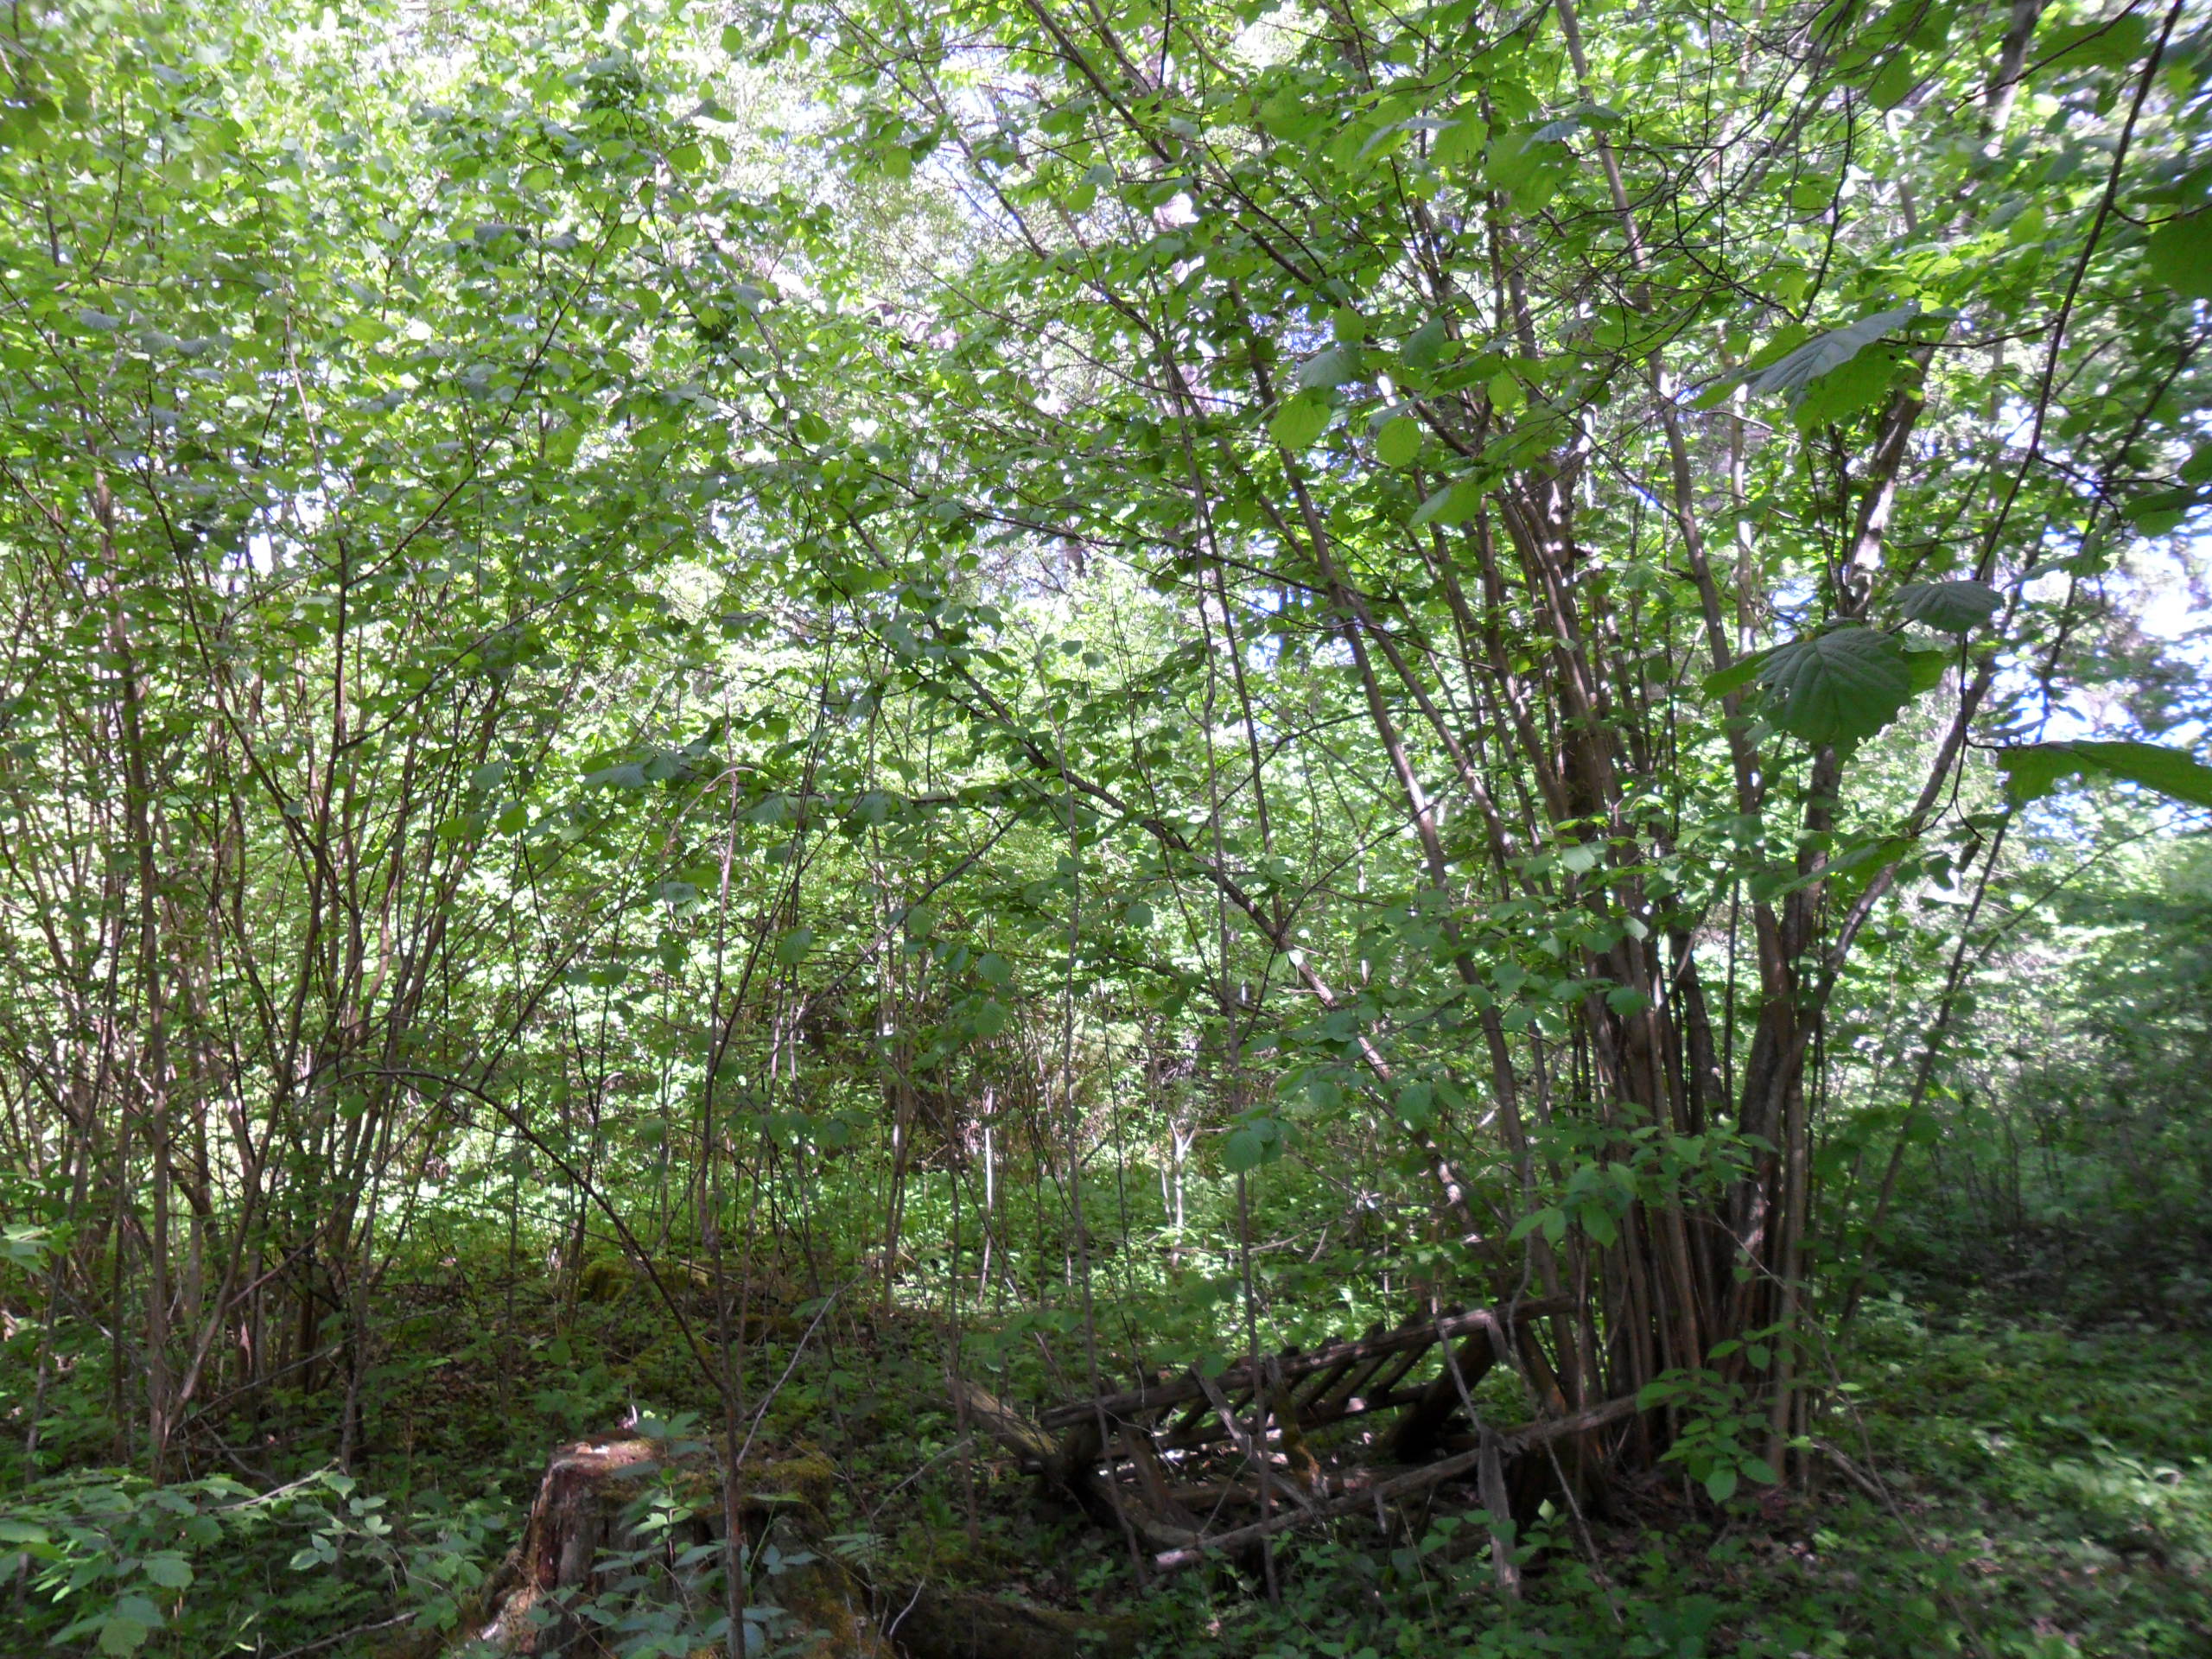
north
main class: Woodland
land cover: Broadleaved woodland
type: non-riverine alder, birch or aspen forest
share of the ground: > 75 %
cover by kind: broadleaved forest trees 70 %, coniferous forest trees 20 %, shrubs 5 %, herbaceous plants 5 %
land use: Forestry
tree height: > 5 m
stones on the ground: < 10 %
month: June
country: LV
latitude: 57.3882
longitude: 22.5818
